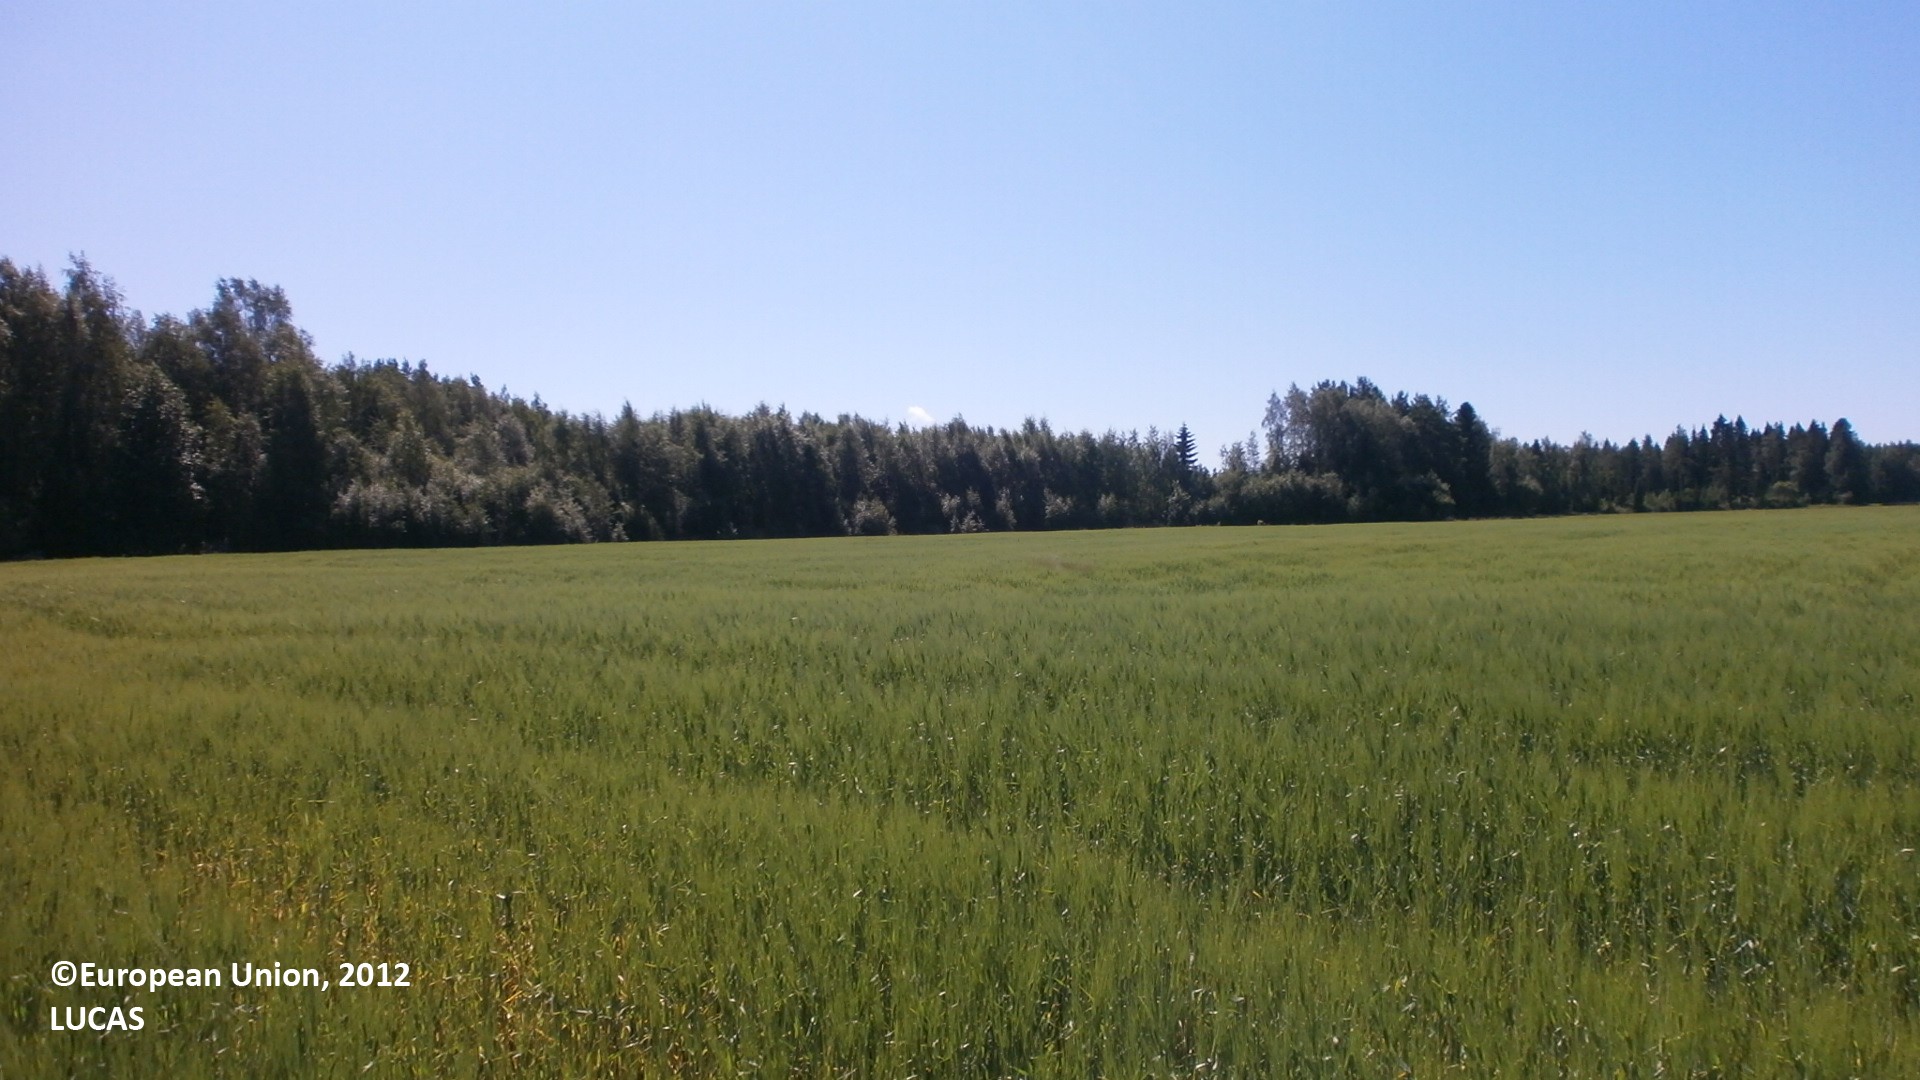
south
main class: Cropland
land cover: Barley
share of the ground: > 75 %
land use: Agriculture (excluding fallow land and kitchen gardens)
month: July
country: FI
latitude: 64.1227
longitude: 23.7992
